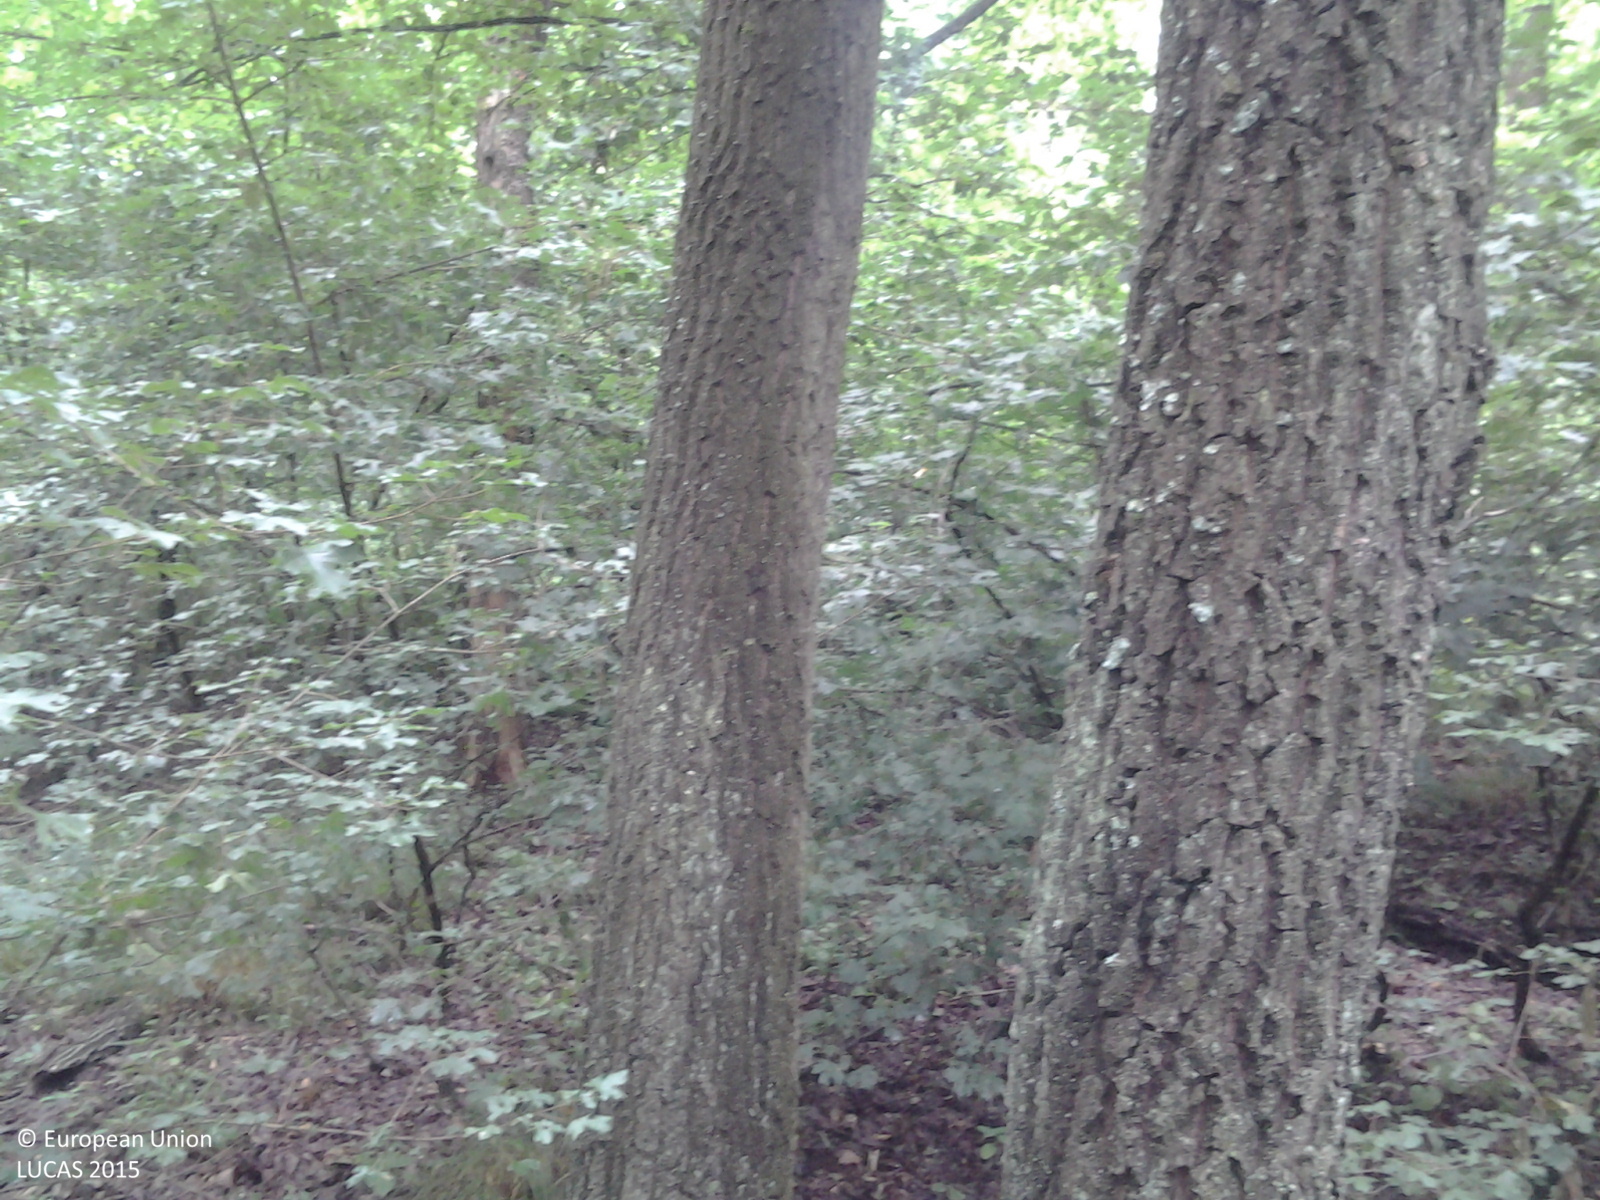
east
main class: Woodland
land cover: Broadleaved woodland
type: mesophytic deciduous forest
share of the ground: > 75 %
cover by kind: broadleaved forest trees 85 %, shrubs 10 %, herbaceous plants 5 %
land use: Forestry
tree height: > 5 m
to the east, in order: Broadleaved woodland
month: June
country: HU
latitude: 46.9030
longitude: 17.2119
